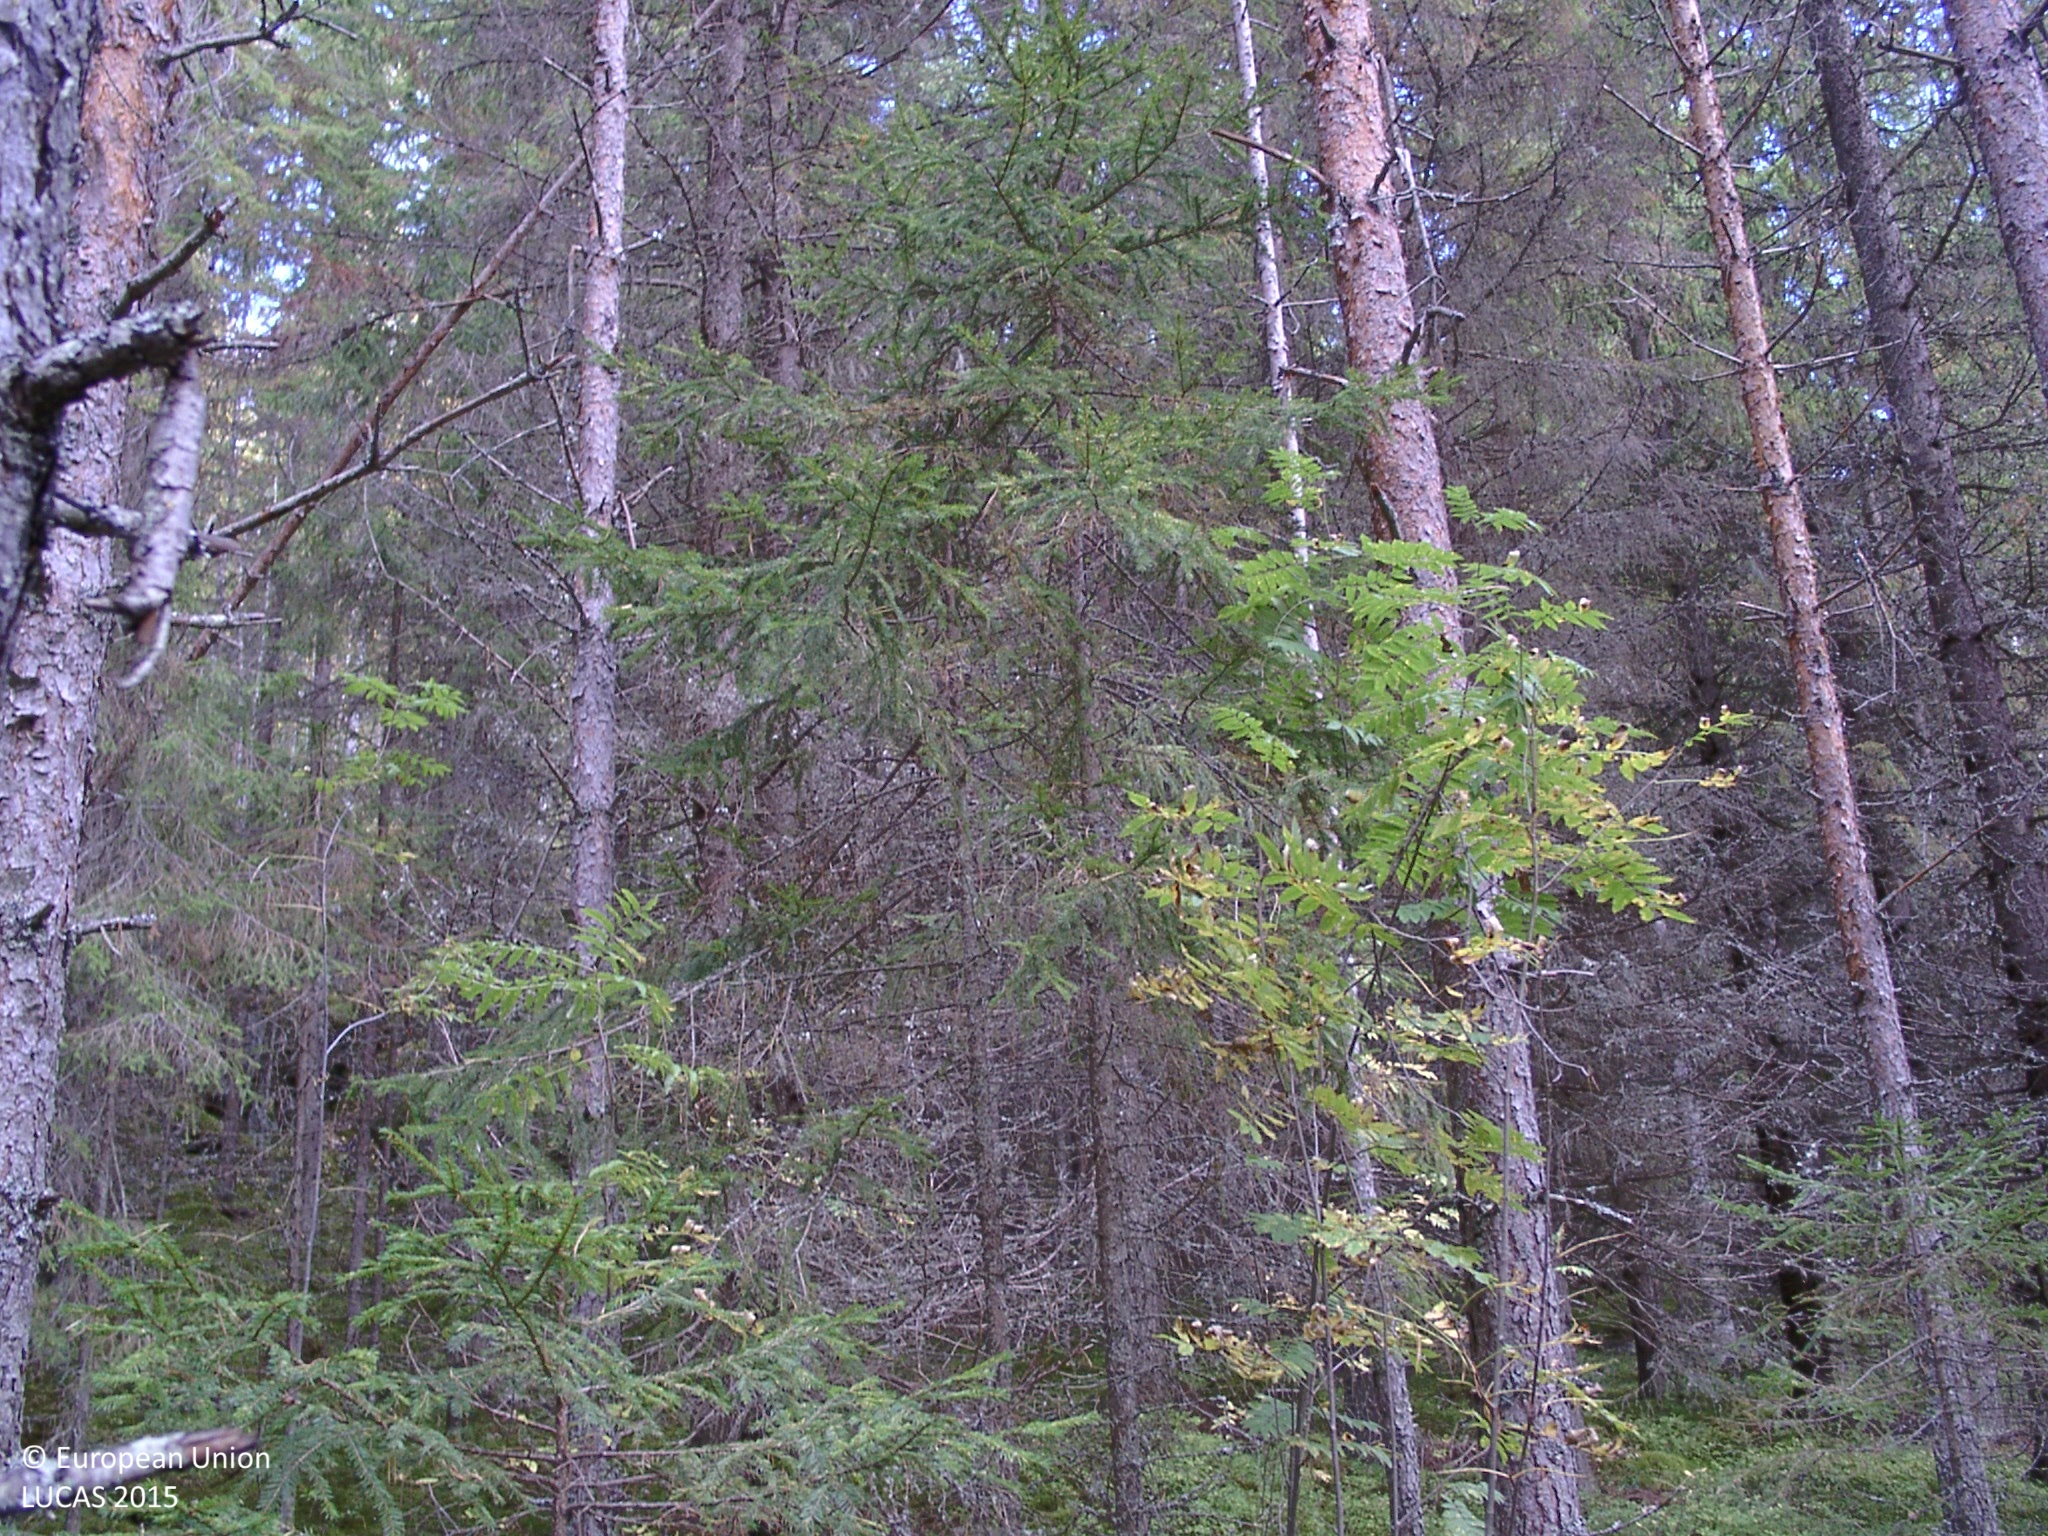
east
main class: Woodland
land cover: Other coniferous woodland
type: boreal forest
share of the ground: > 75 %
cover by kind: coniferous forest trees 80 %, shrubs 10 %, herbaceous plants 5 %, lichens and mosses 5 %
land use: Forestry
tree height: > 5 m
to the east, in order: Other coniferous woodland; Other mixed woodland; Other coniferous woodland; Spruce dominated coniferous woodland; Tracks; Spruce dominated coniferous woodland; Tracks; Other coniferous woodland; Tracks; Pine dominated coniferous woodland; Tracks; Pine dominated coniferous woodland; Tracks; Pine dominated coniferous woodland
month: September
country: FI
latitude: 62.5611
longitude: 25.2987
